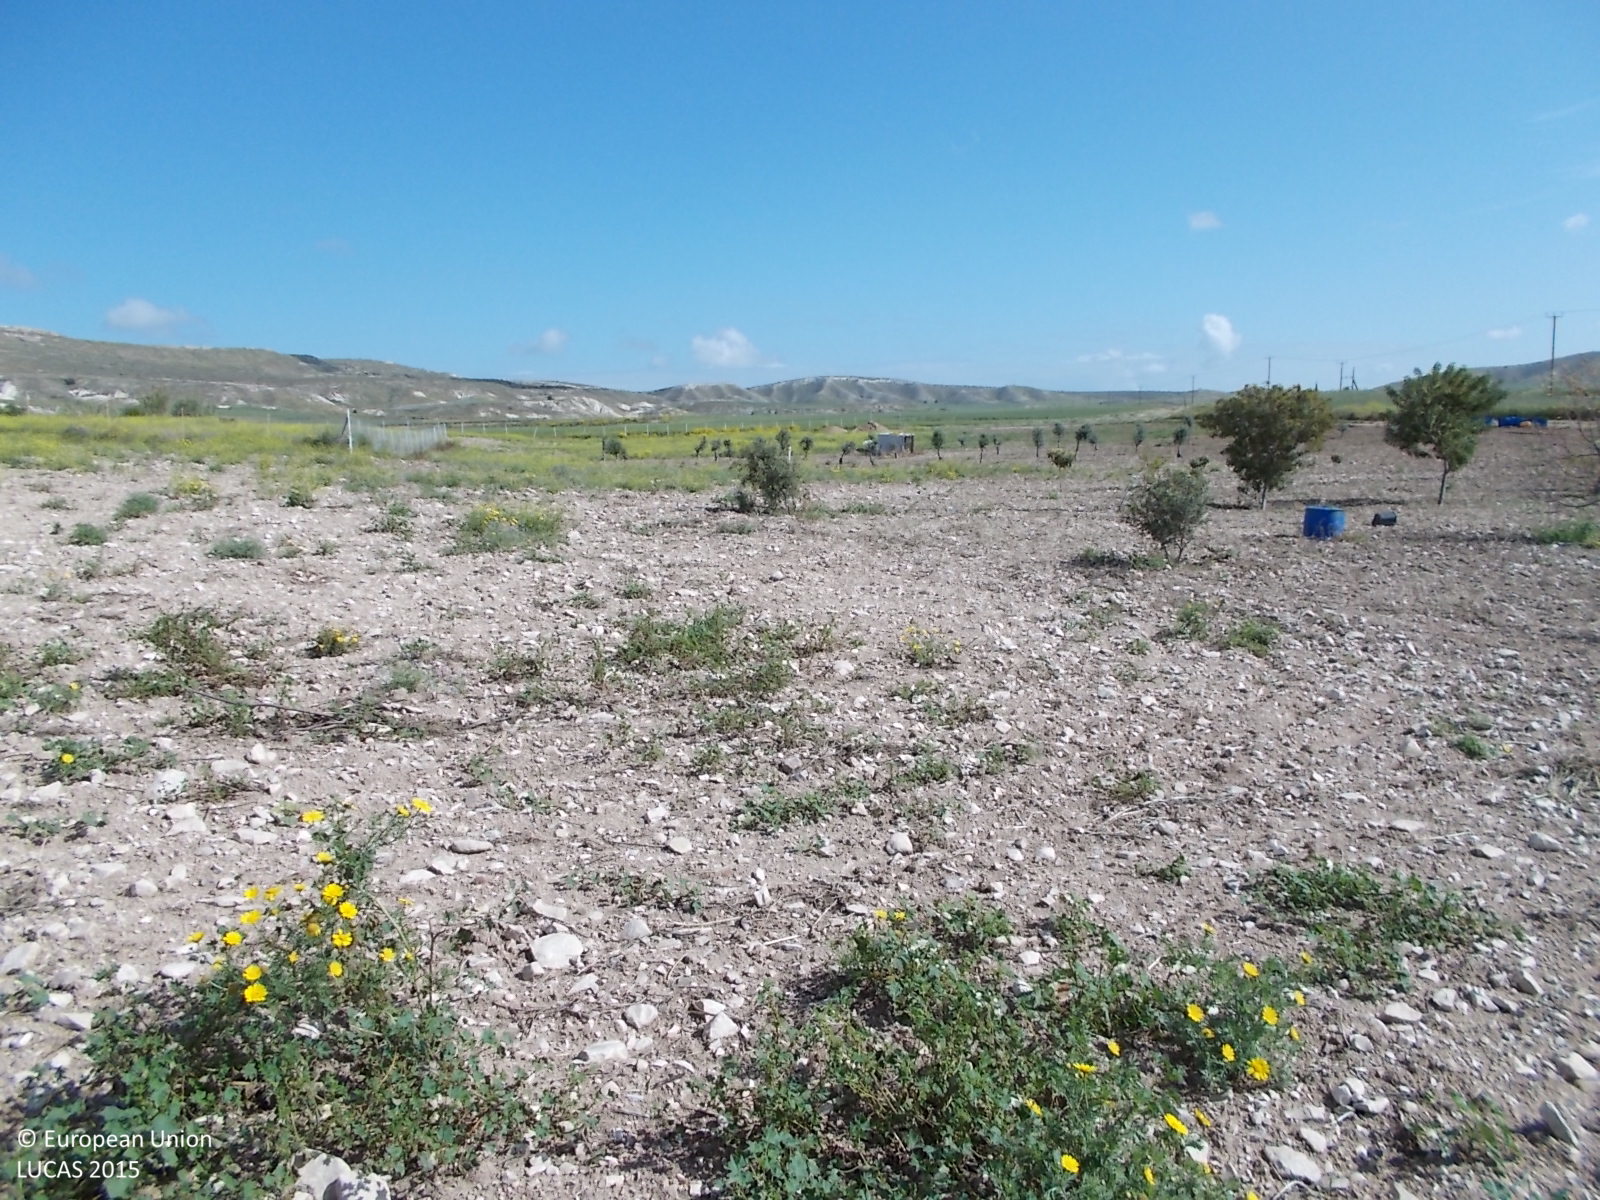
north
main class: Grassland
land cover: Spontaneously vegetated surfaces
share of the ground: 25 - 50 %
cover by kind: unconsolidated bare surface 75 %, herbaceous plants 25 %
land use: Fallow land
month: April
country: CY
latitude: 35.0324
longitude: 33.6011
